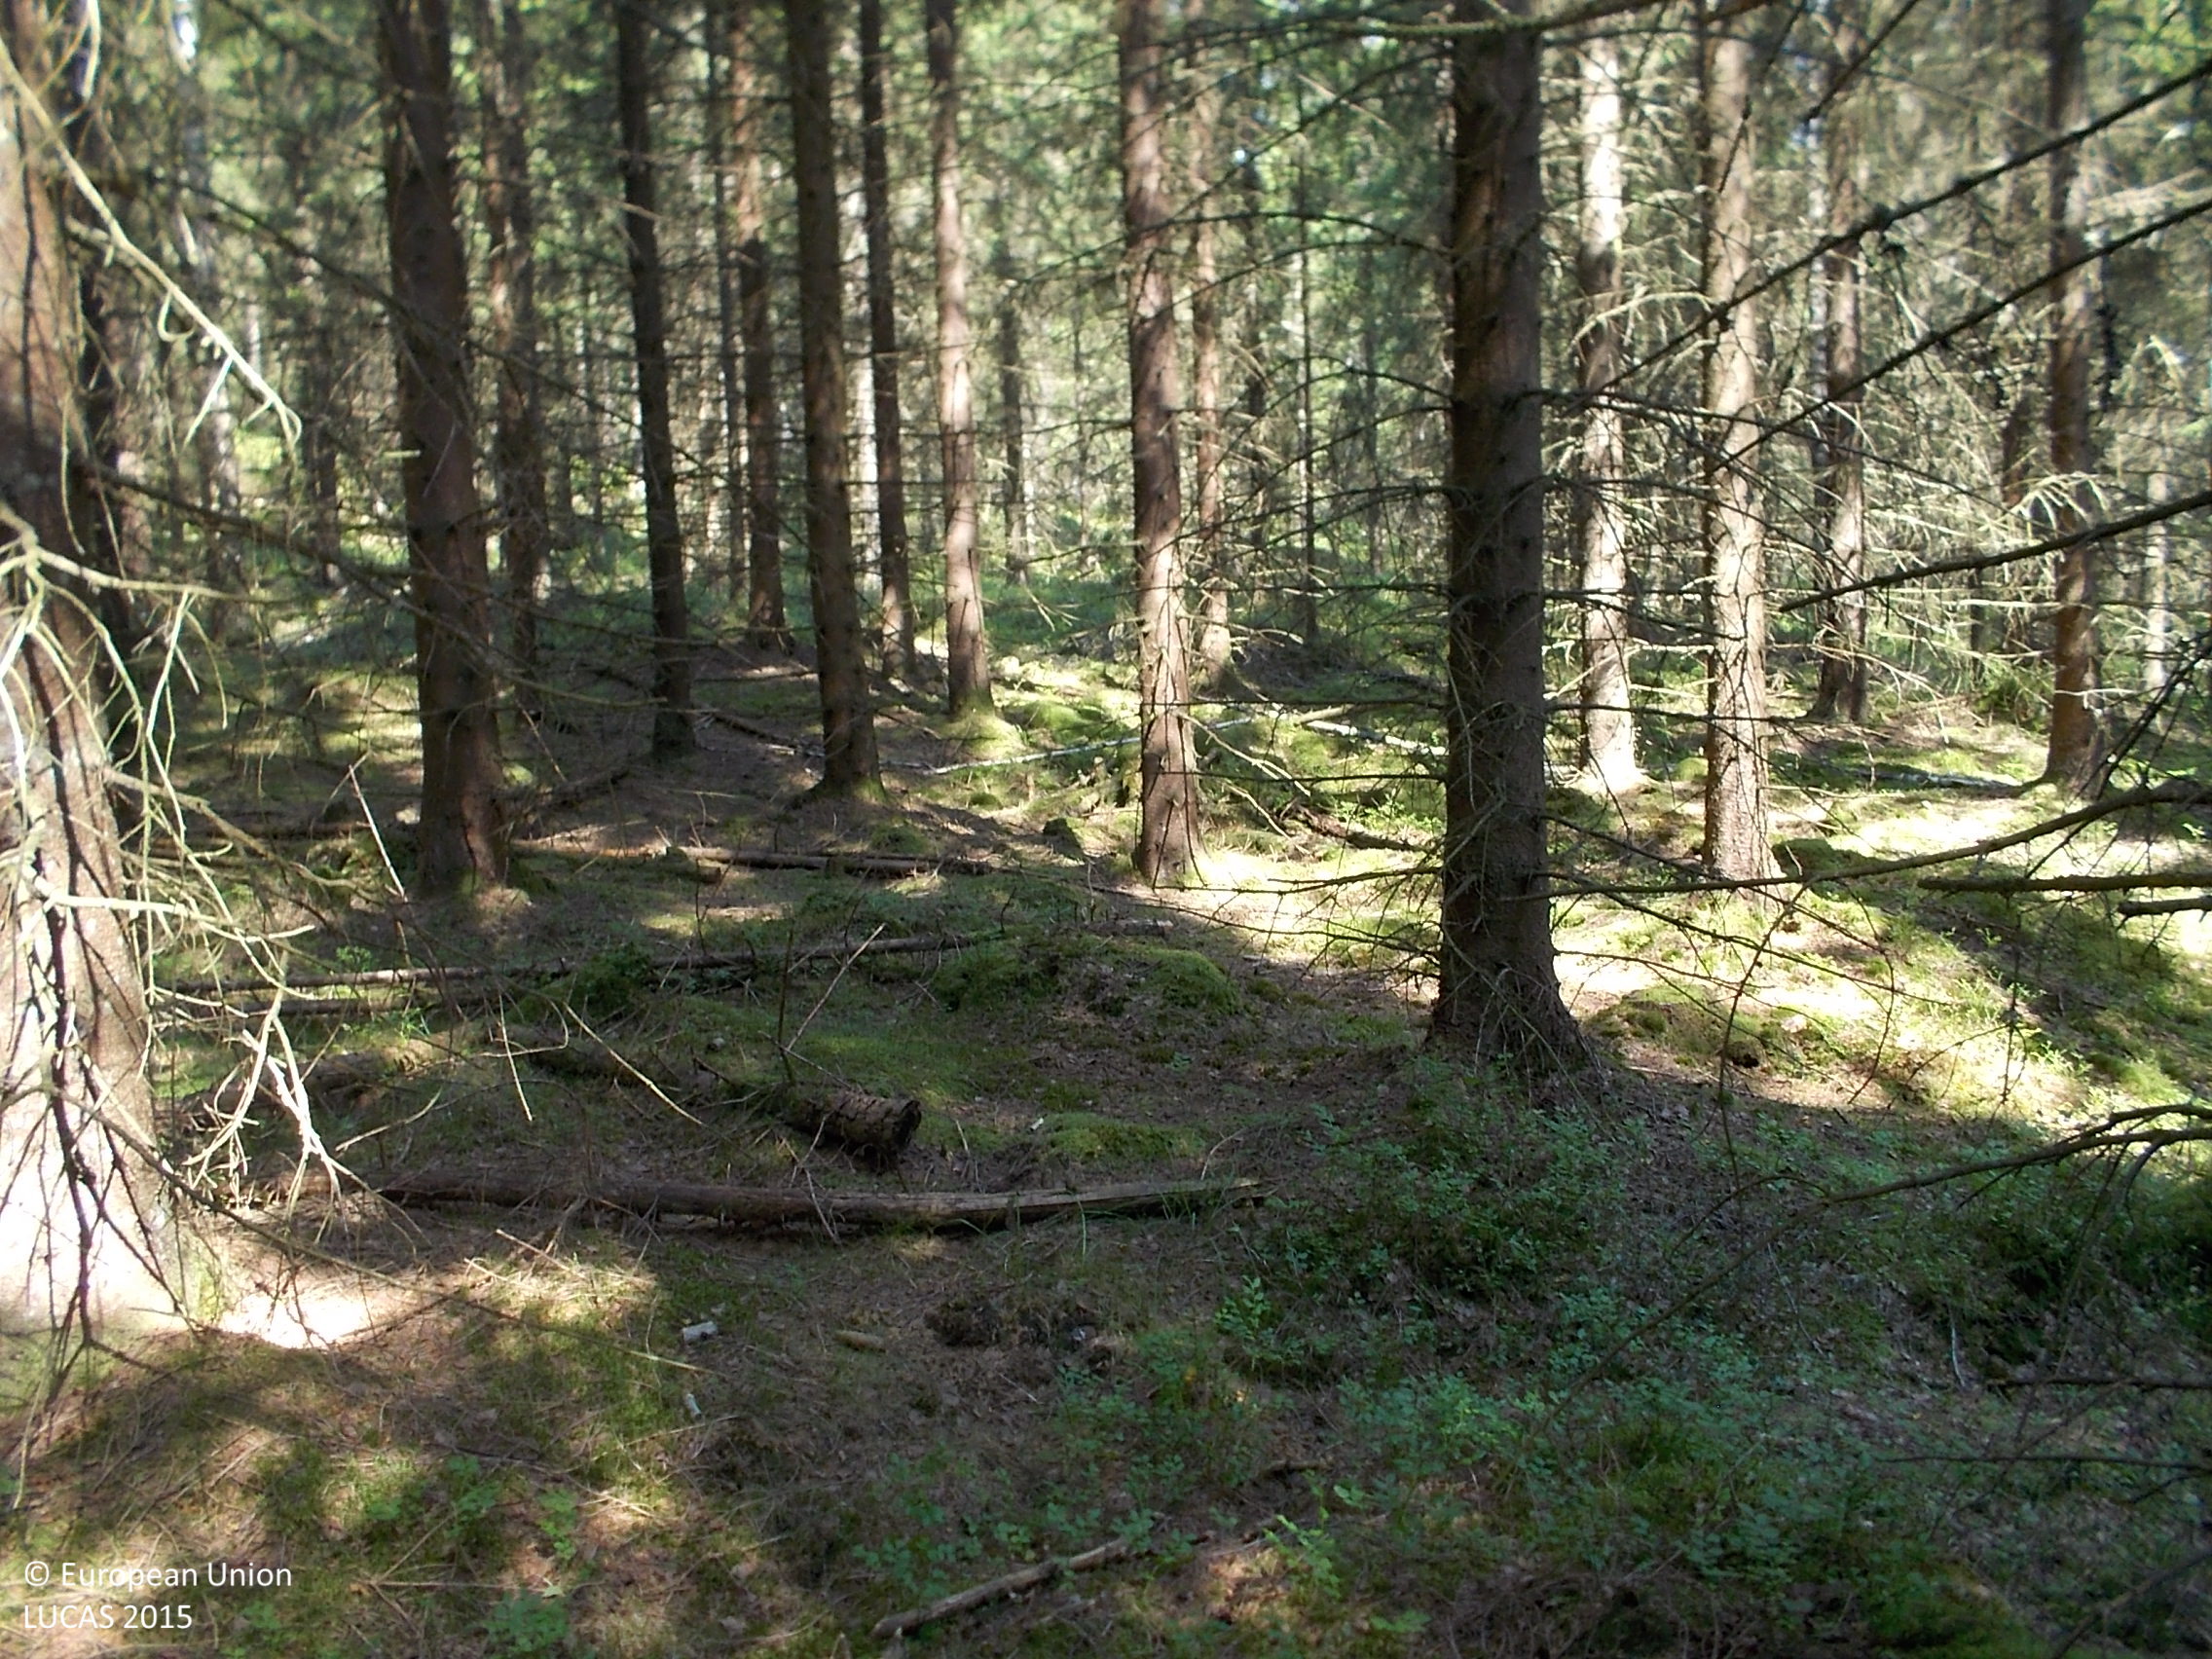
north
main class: Woodland
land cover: Spruce dominated coniferous woodland
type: boreal forest
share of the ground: > 75 %
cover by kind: coniferous forest trees 80 %, shrubs 10 %, lichens and mosses 10 %
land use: Forestry
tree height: > 5 m
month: August
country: SE
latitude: 57.5541
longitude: 13.0874
